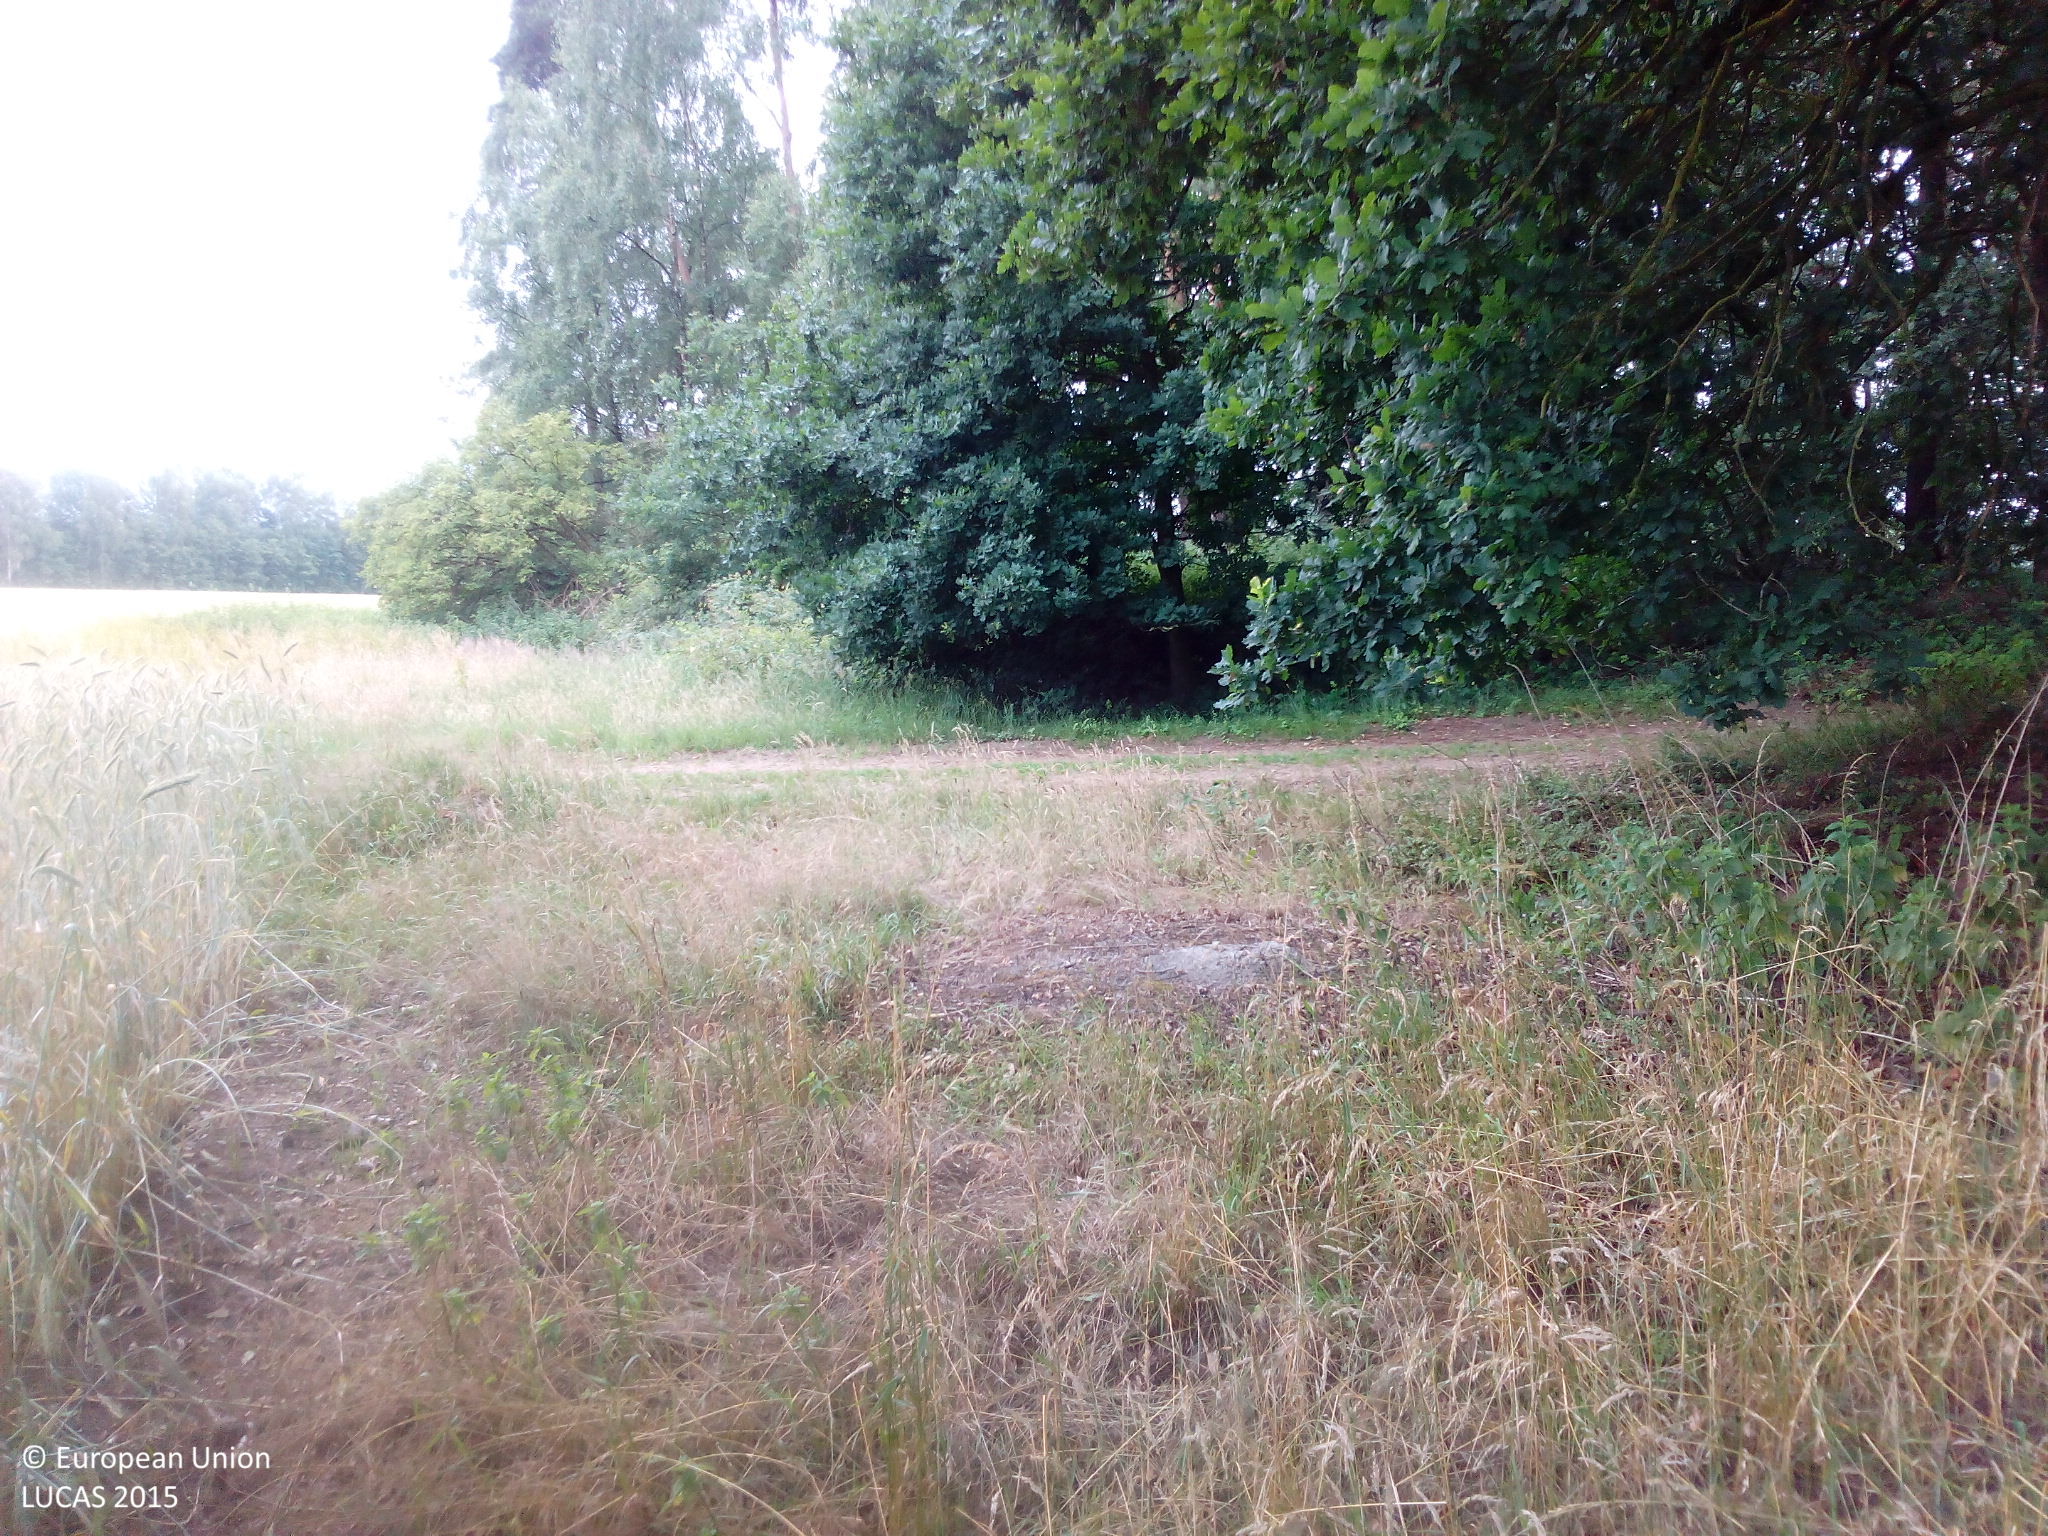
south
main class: Cropland
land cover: Rye
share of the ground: > 75 %
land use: Agriculture (excluding fallow land and kitchen gardens)
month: July
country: DE
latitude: 51.7759
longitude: 8.5945
